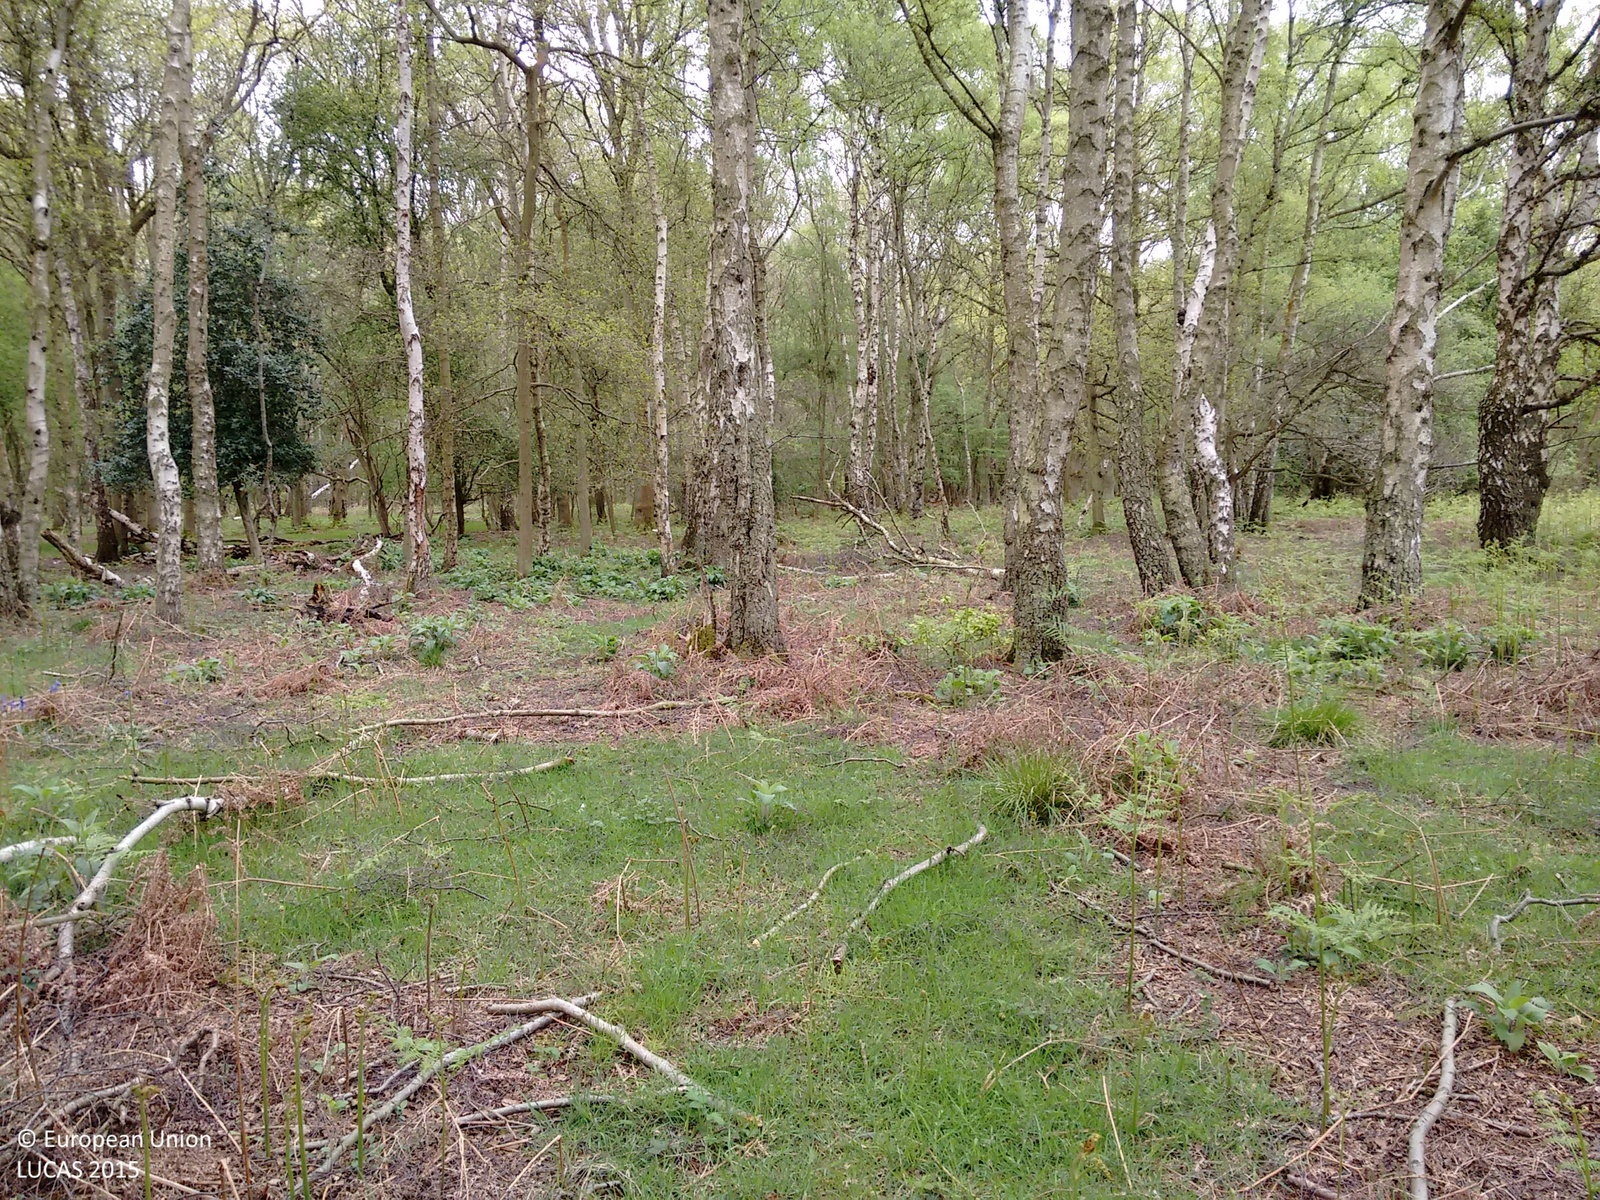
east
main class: Woodland
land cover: Broadleaved woodland
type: mesophytic deciduous forest
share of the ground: > 75 %
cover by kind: broadleaved forest trees 80 %, herbaceous plants 20 %
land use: Forestry
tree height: > 5 m
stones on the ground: 10 - 25 %
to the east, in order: Broadleaved woodland; Tracks; Broadleaved woodland
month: May
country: GB
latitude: 51.7944
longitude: -0.5803
